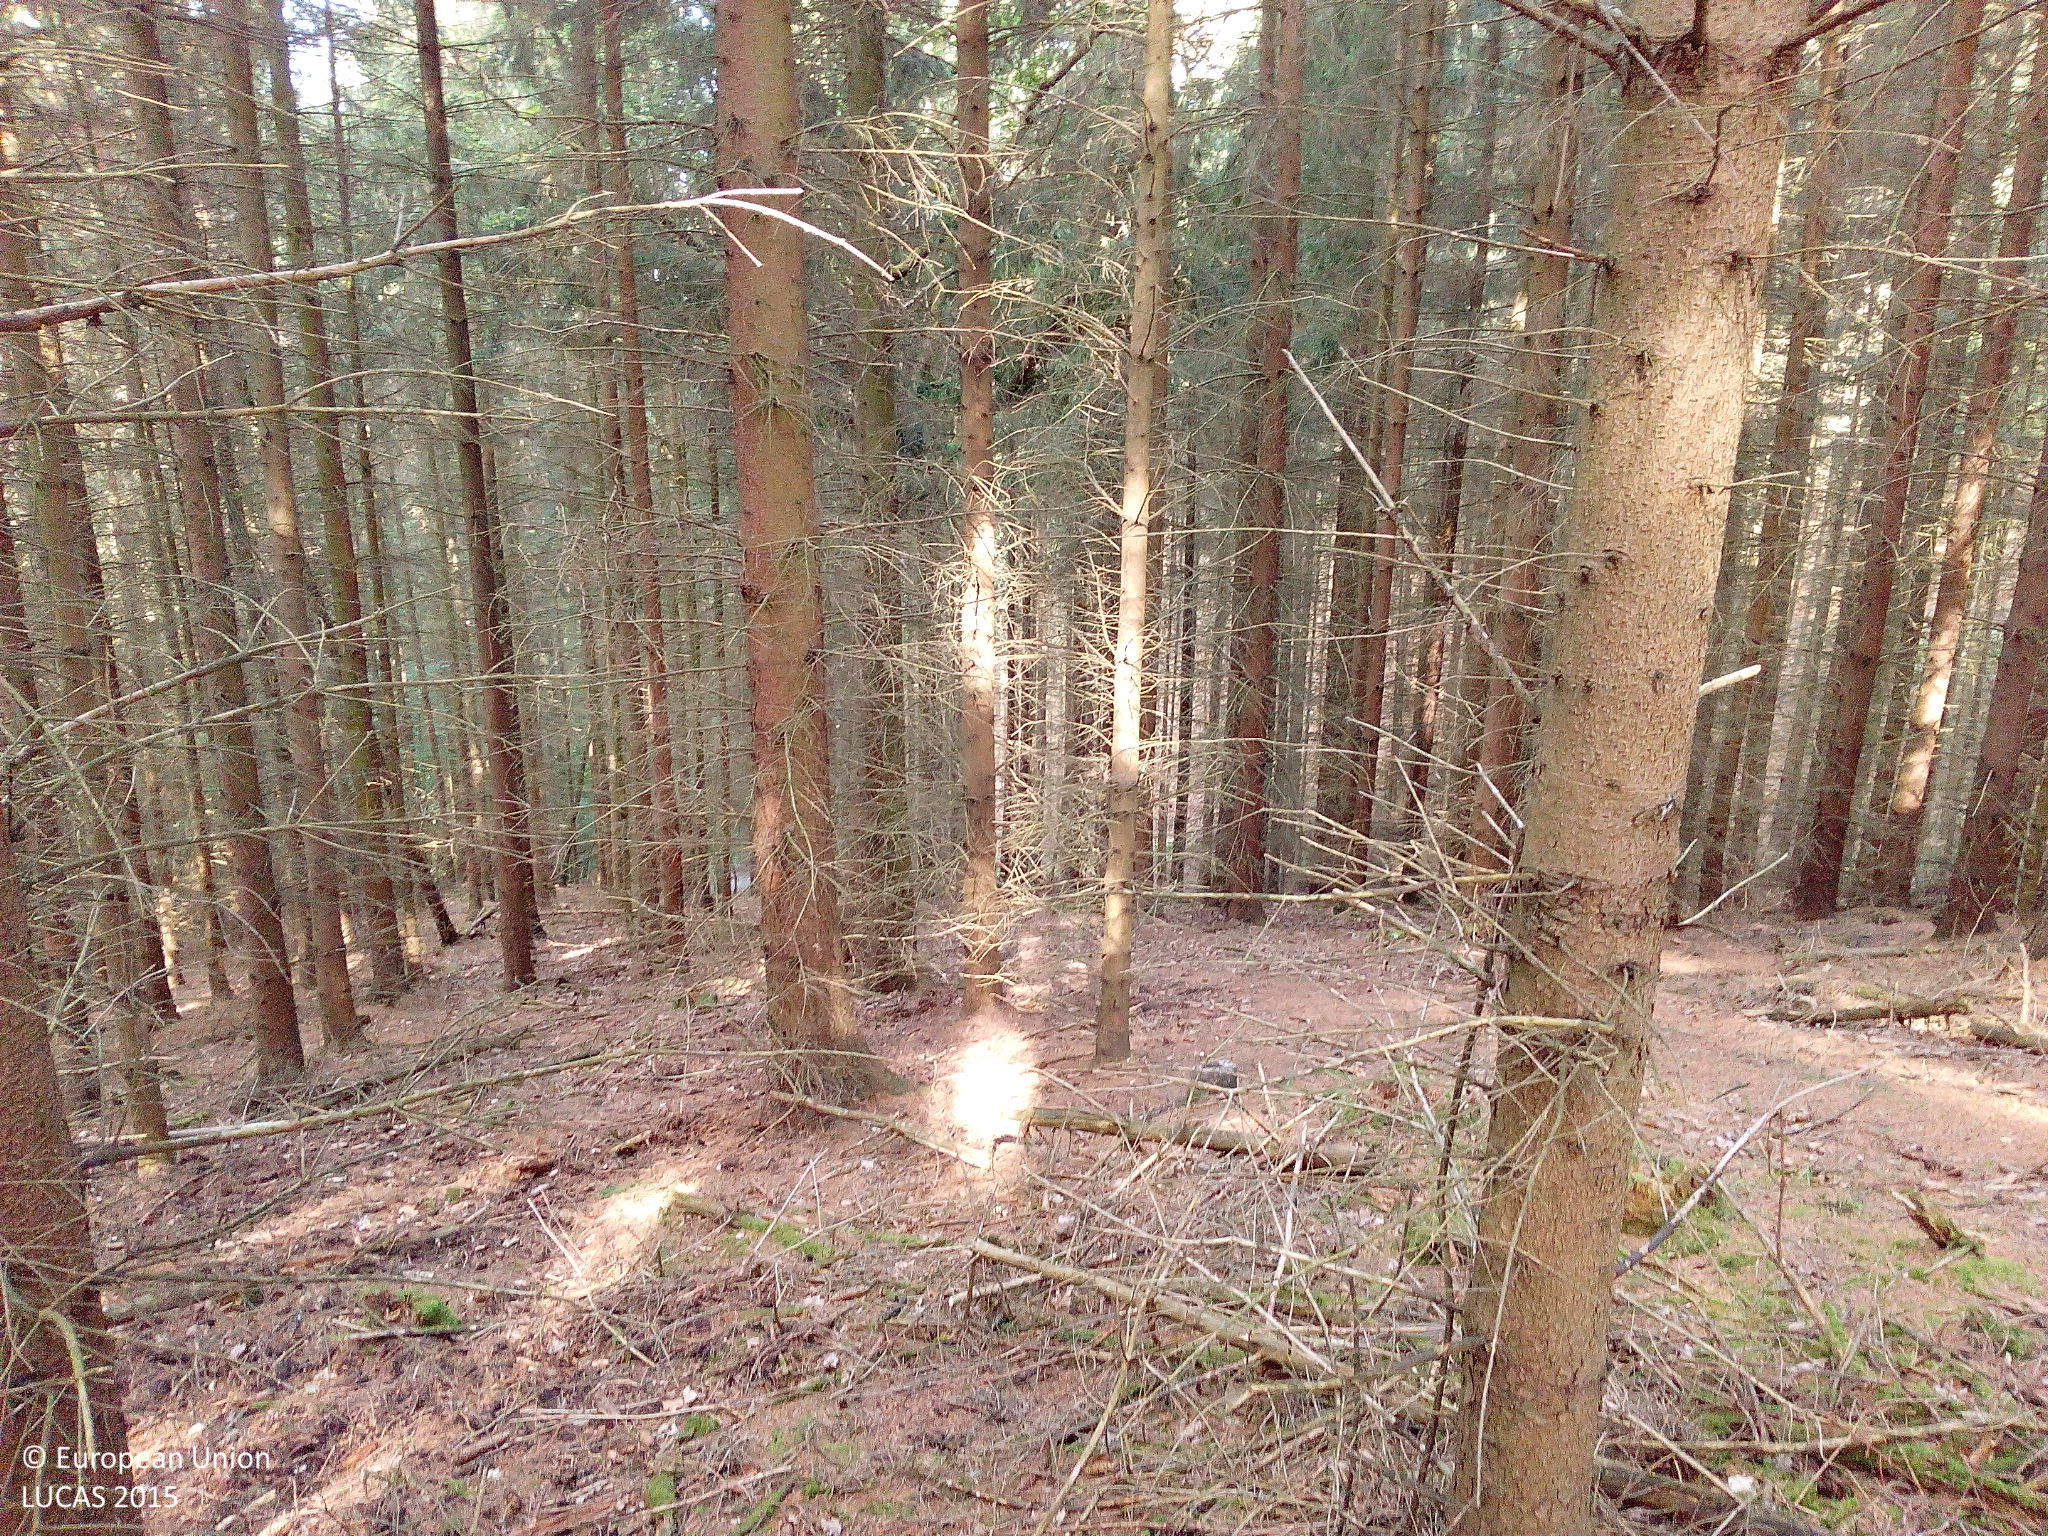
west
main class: Woodland
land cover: Spruce dominated coniferous woodland
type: hemiboreal forest and nemoral coniferous forest and mixed broadleaved-coniferous forest
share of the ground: > 75 %
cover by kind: coniferous forest trees 95 %, unconsolidated bare surface 5 %
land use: Forestry
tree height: > 5 m
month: July
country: DE
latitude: 51.0832
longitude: 9.9572
